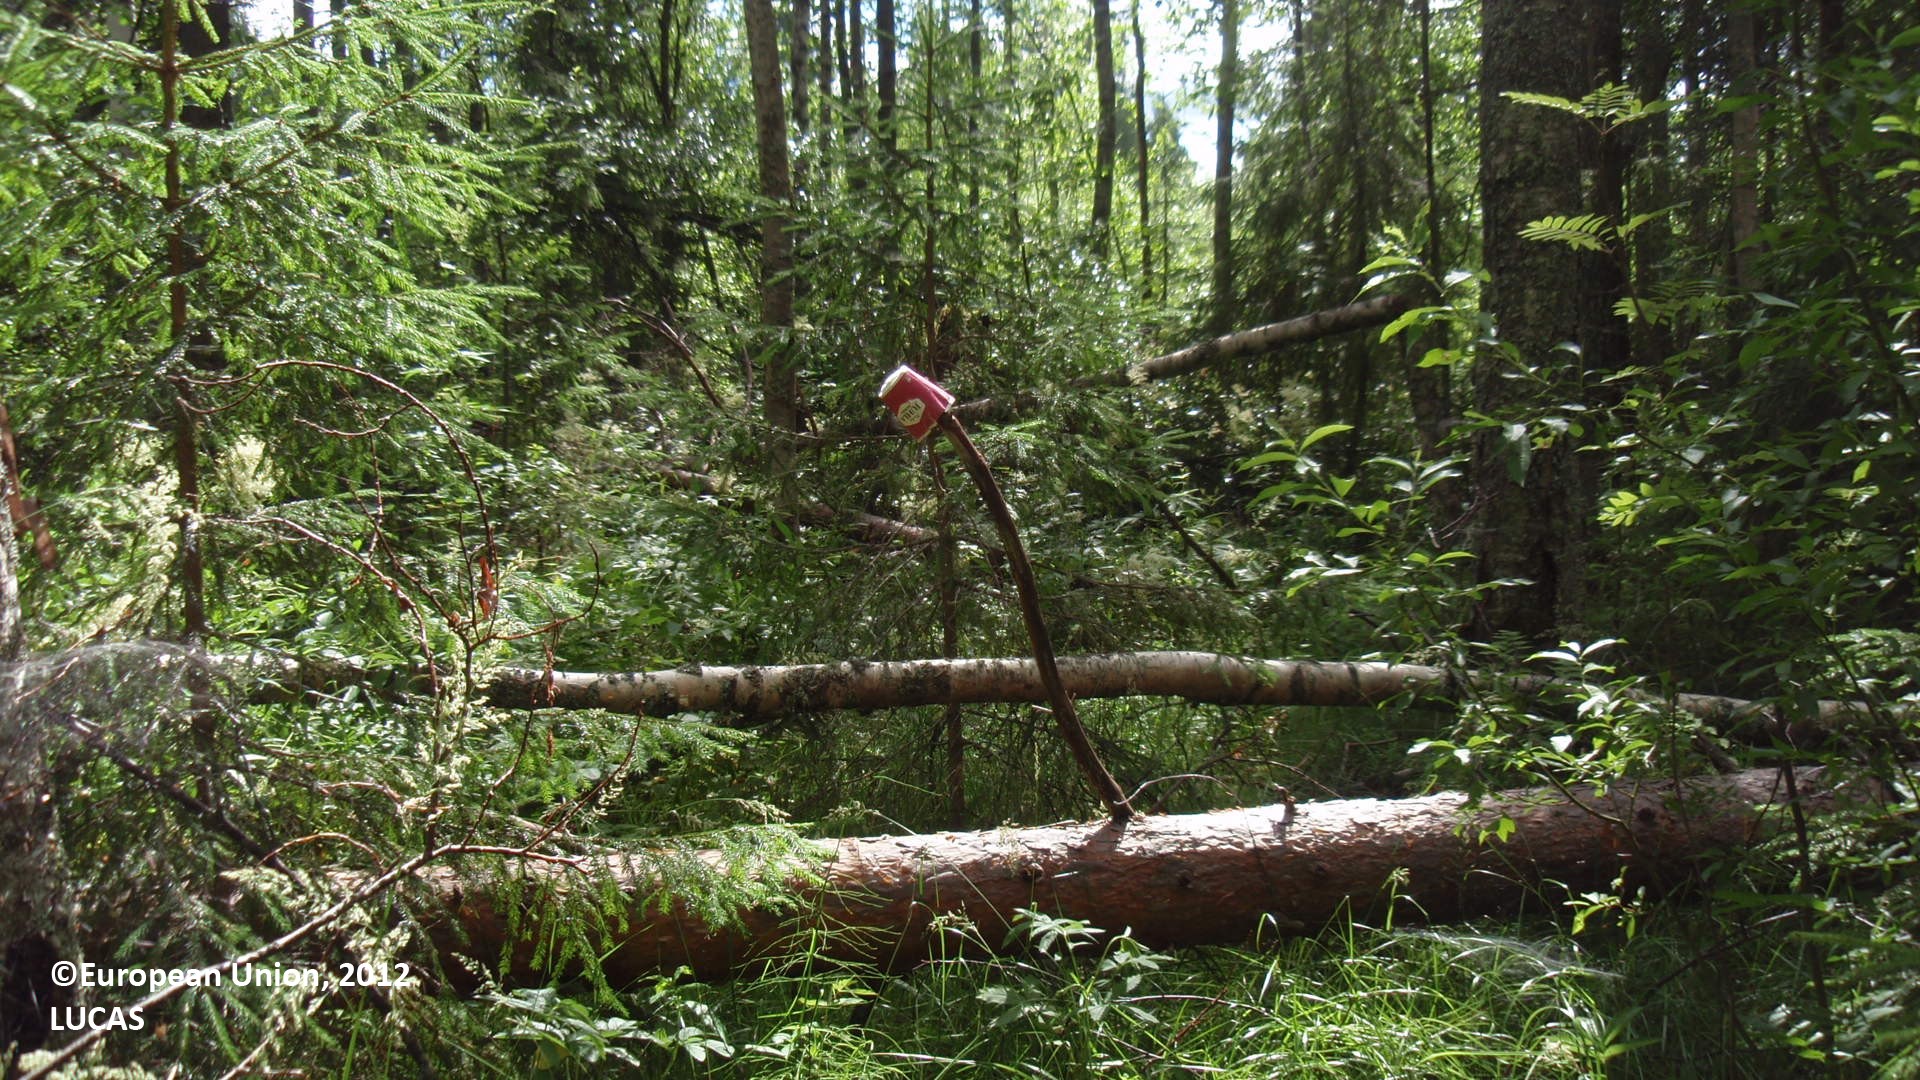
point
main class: Woodland
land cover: Spruce dominated mixed woodland
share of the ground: 50 - 75 %
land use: Forestry
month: July
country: FI
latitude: 61.6371
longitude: 27.4402
